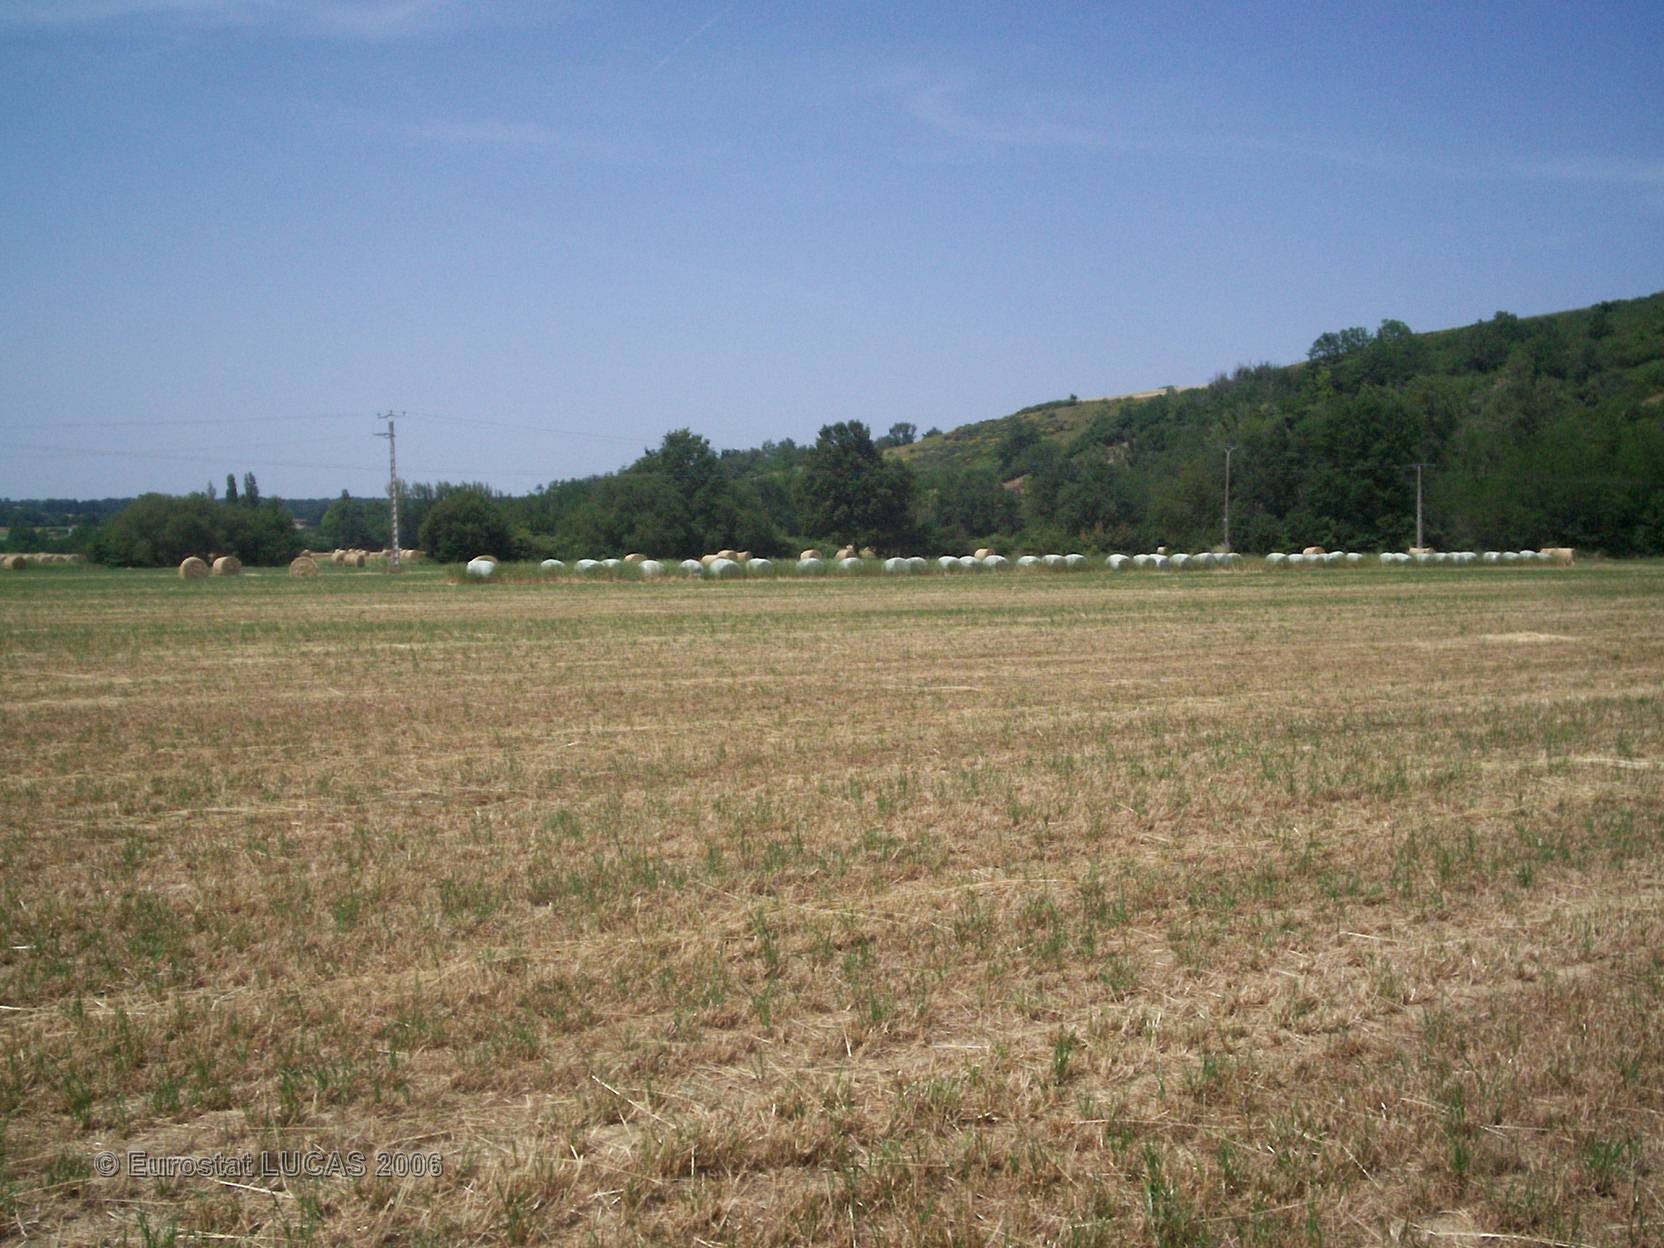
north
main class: Grassland
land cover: Grassland without tree/shrub cover
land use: Agriculture (excluding fallow land and kitchen gardens)
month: June
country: FR
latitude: 43.1944
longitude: 1.1806
